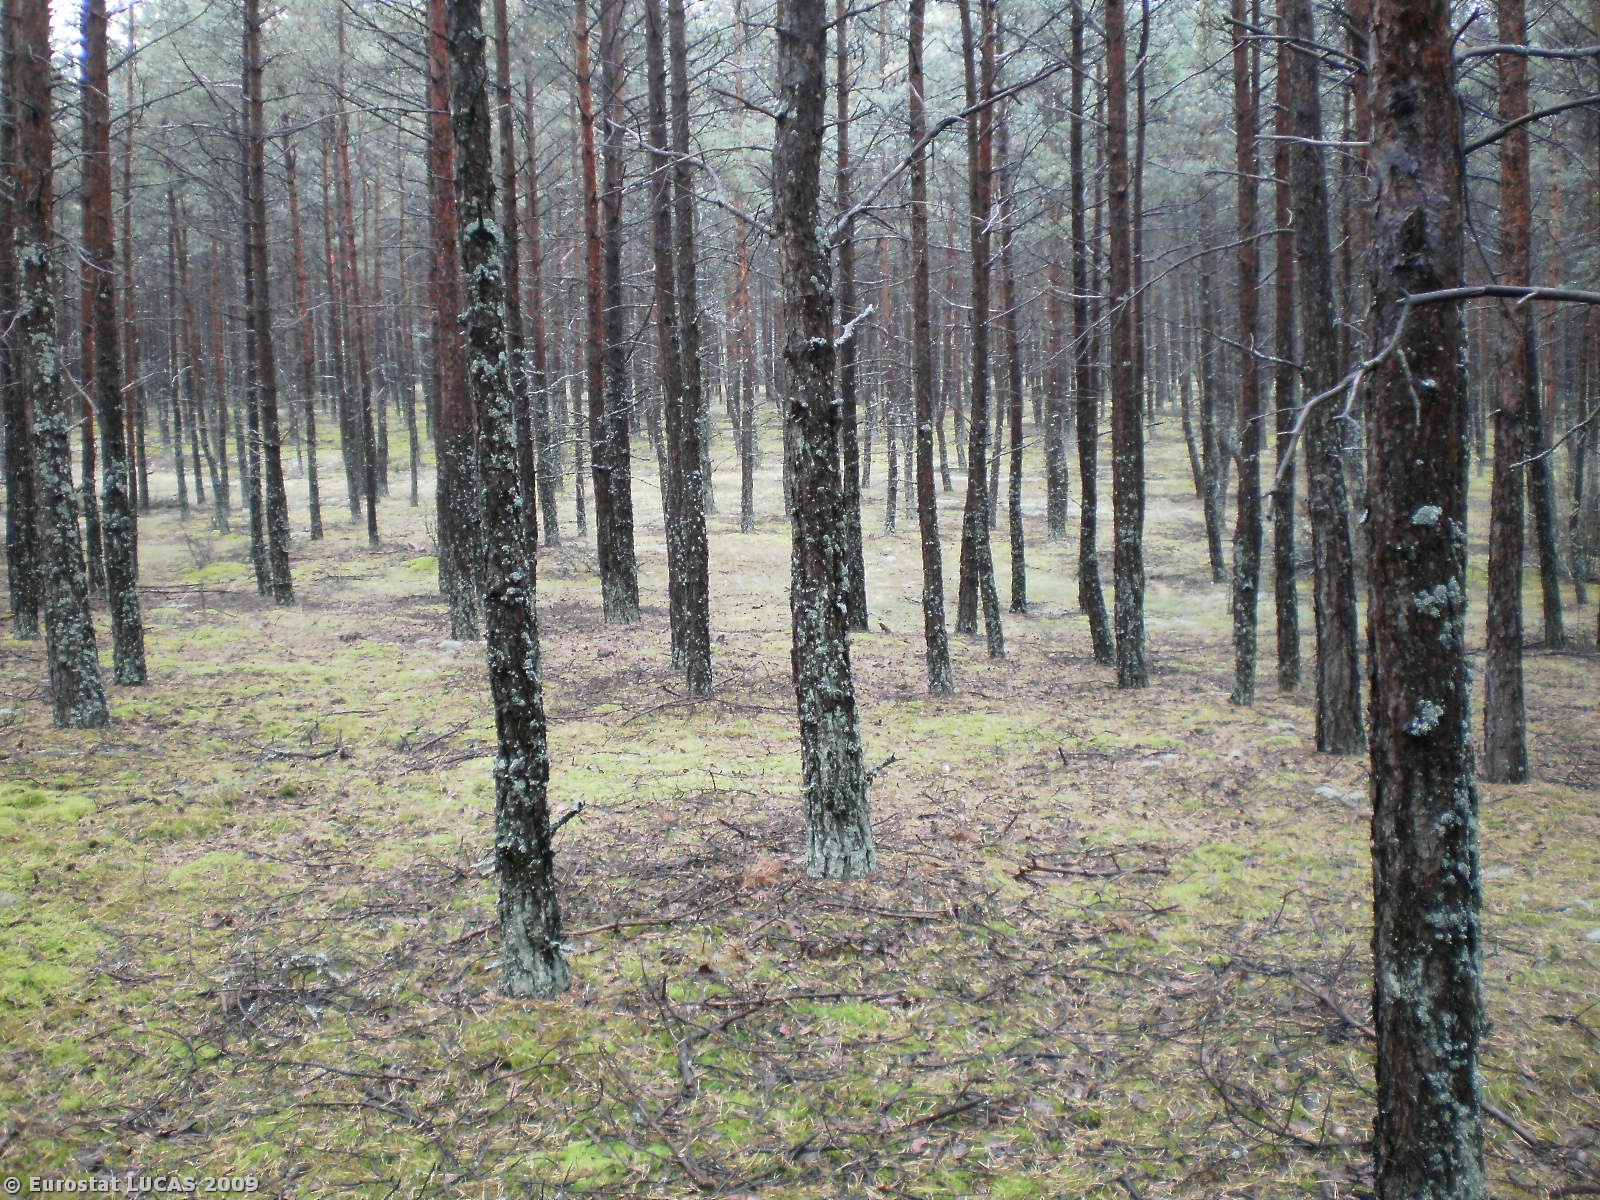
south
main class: Woodland
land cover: Coniferous woodland
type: hemiboreal forest and nemoral coniferous forest and mixed broadleaved-coniferous forest
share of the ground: > 75 %
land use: Forestry
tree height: > 5 m
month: September
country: PL
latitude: 53.8341
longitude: 17.8389
